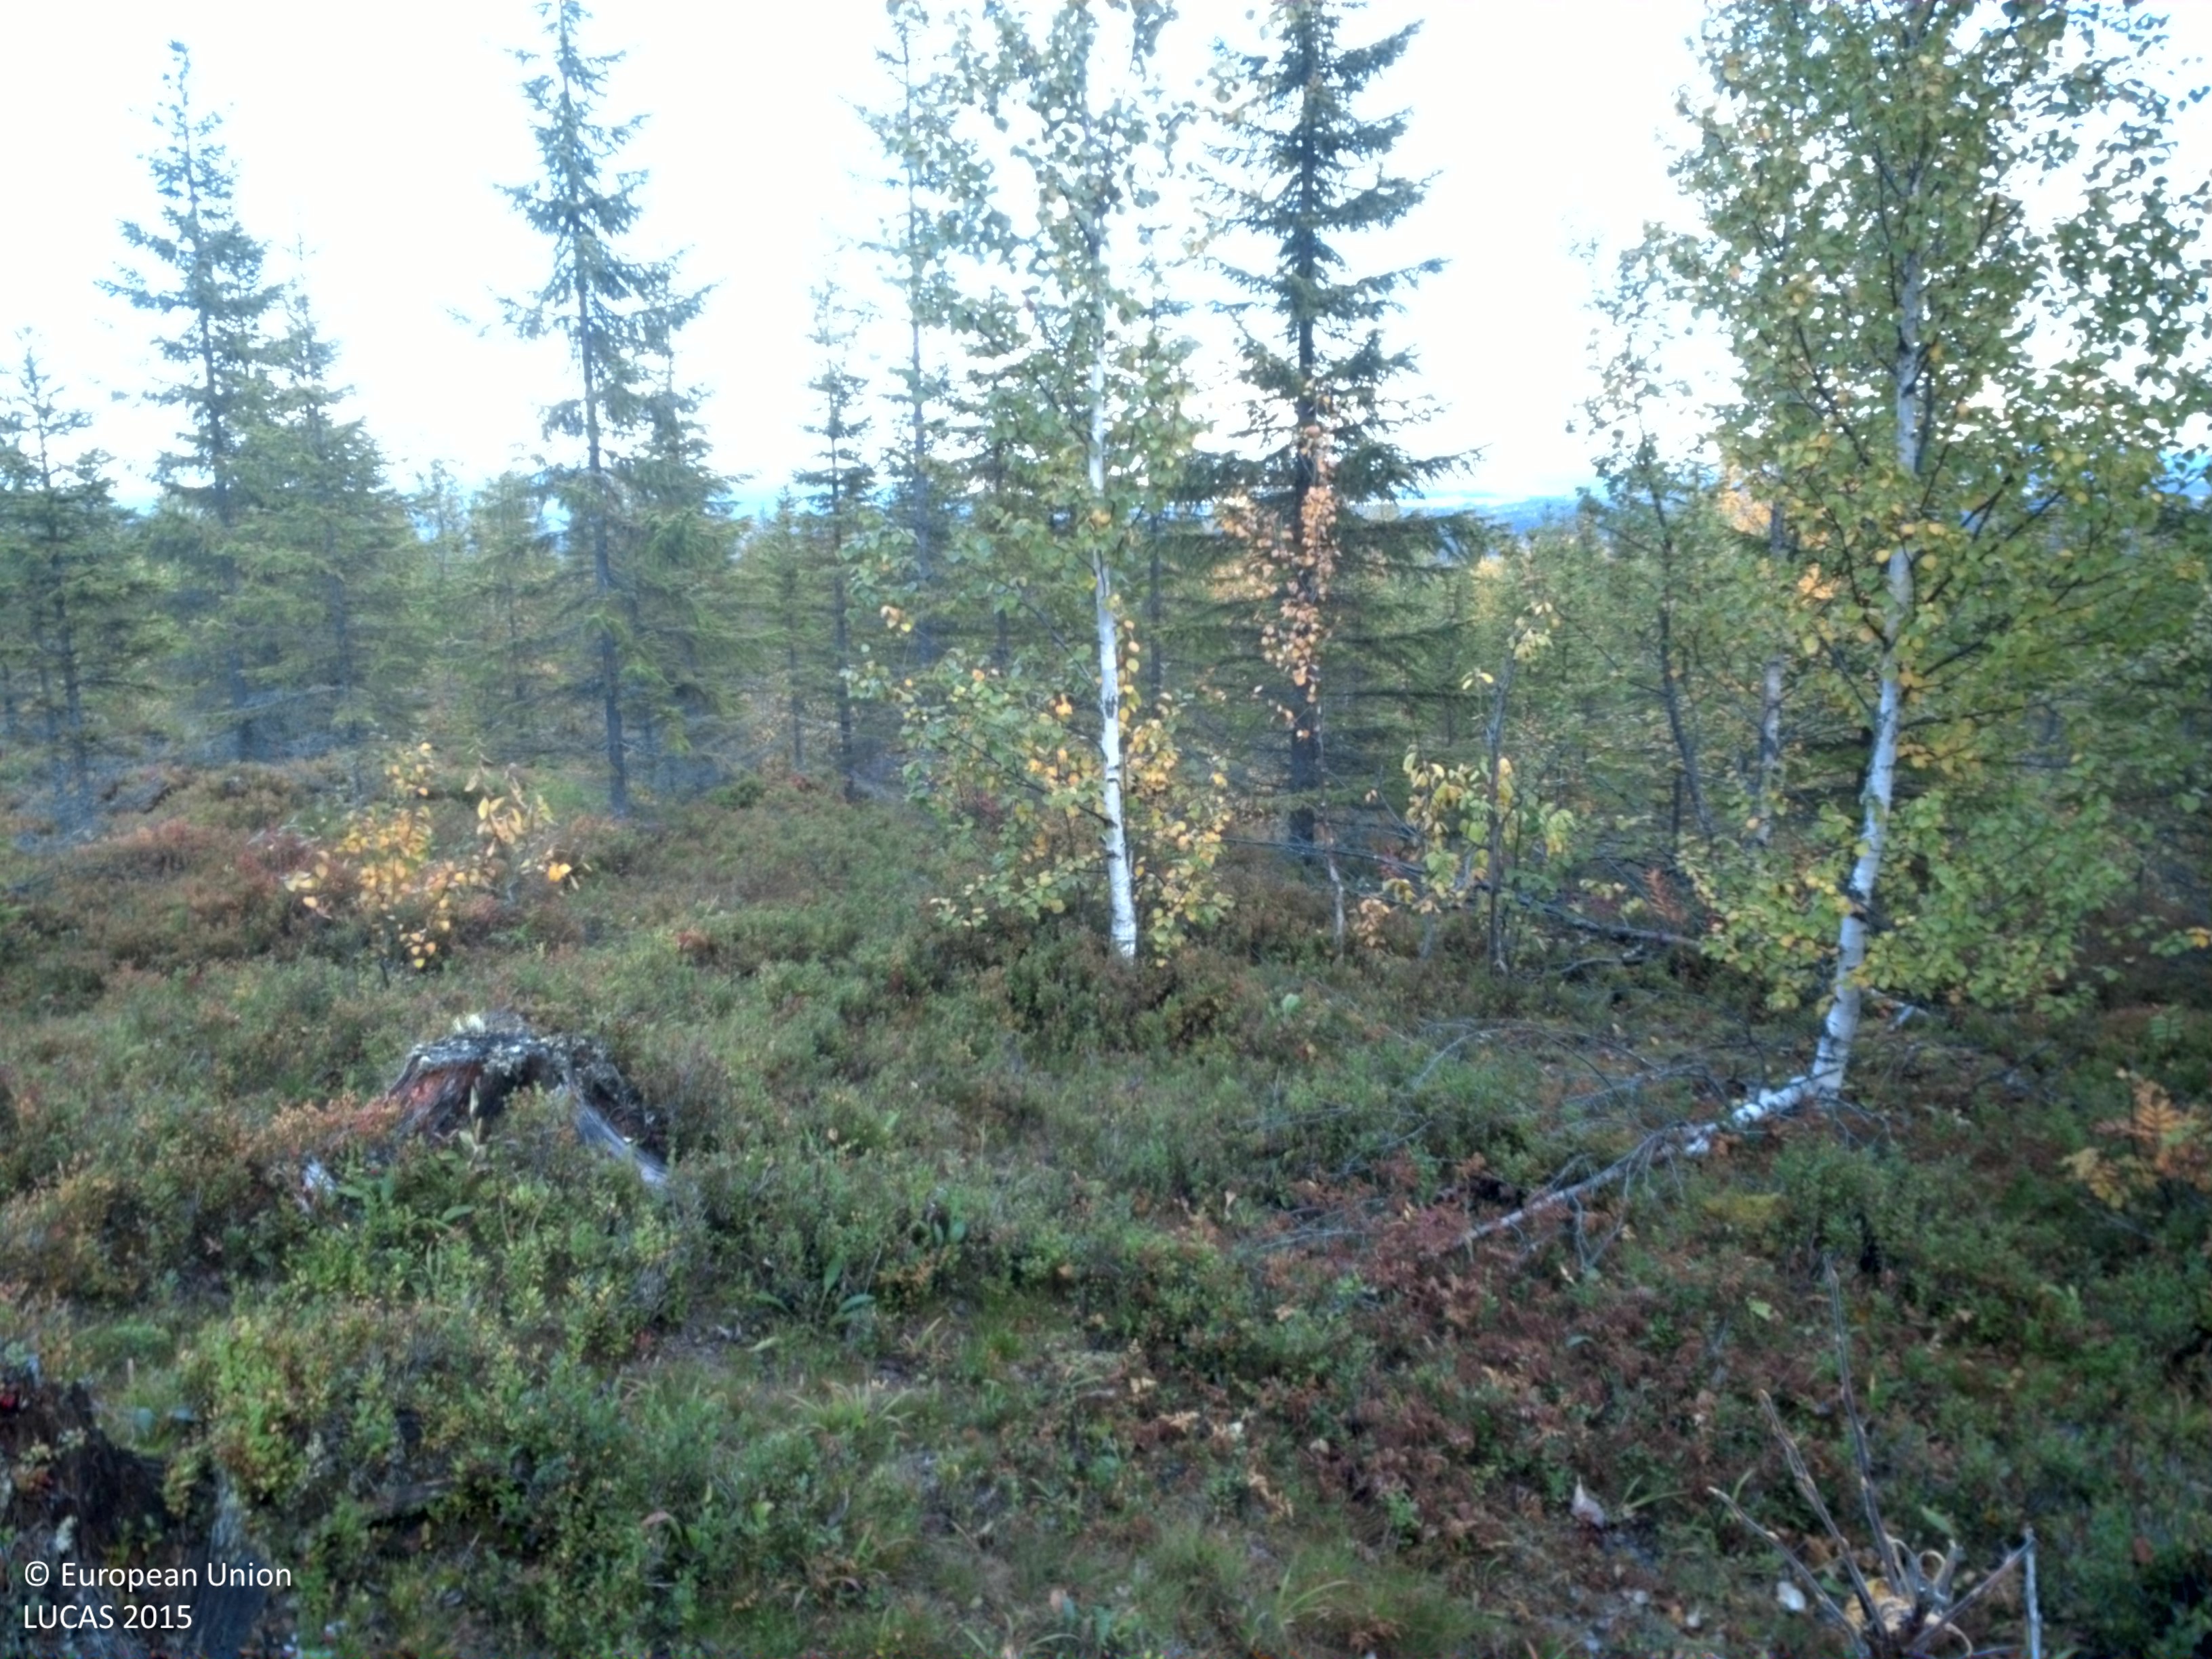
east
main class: Woodland
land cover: Spruce dominated mixed woodland
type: boreal forest
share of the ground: 10 - 25 %
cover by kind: shrubs 50 %, coniferous forest trees 15 %, herbaceous plants 15 %, lichens and mosses 15 %, broadleaved forest trees 5 %
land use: Forestry
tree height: > 5 m
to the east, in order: Spruce dominated mixed woodland; Spruce dominated coniferous woodland
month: September
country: SE
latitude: 65.0620
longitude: 16.9567
